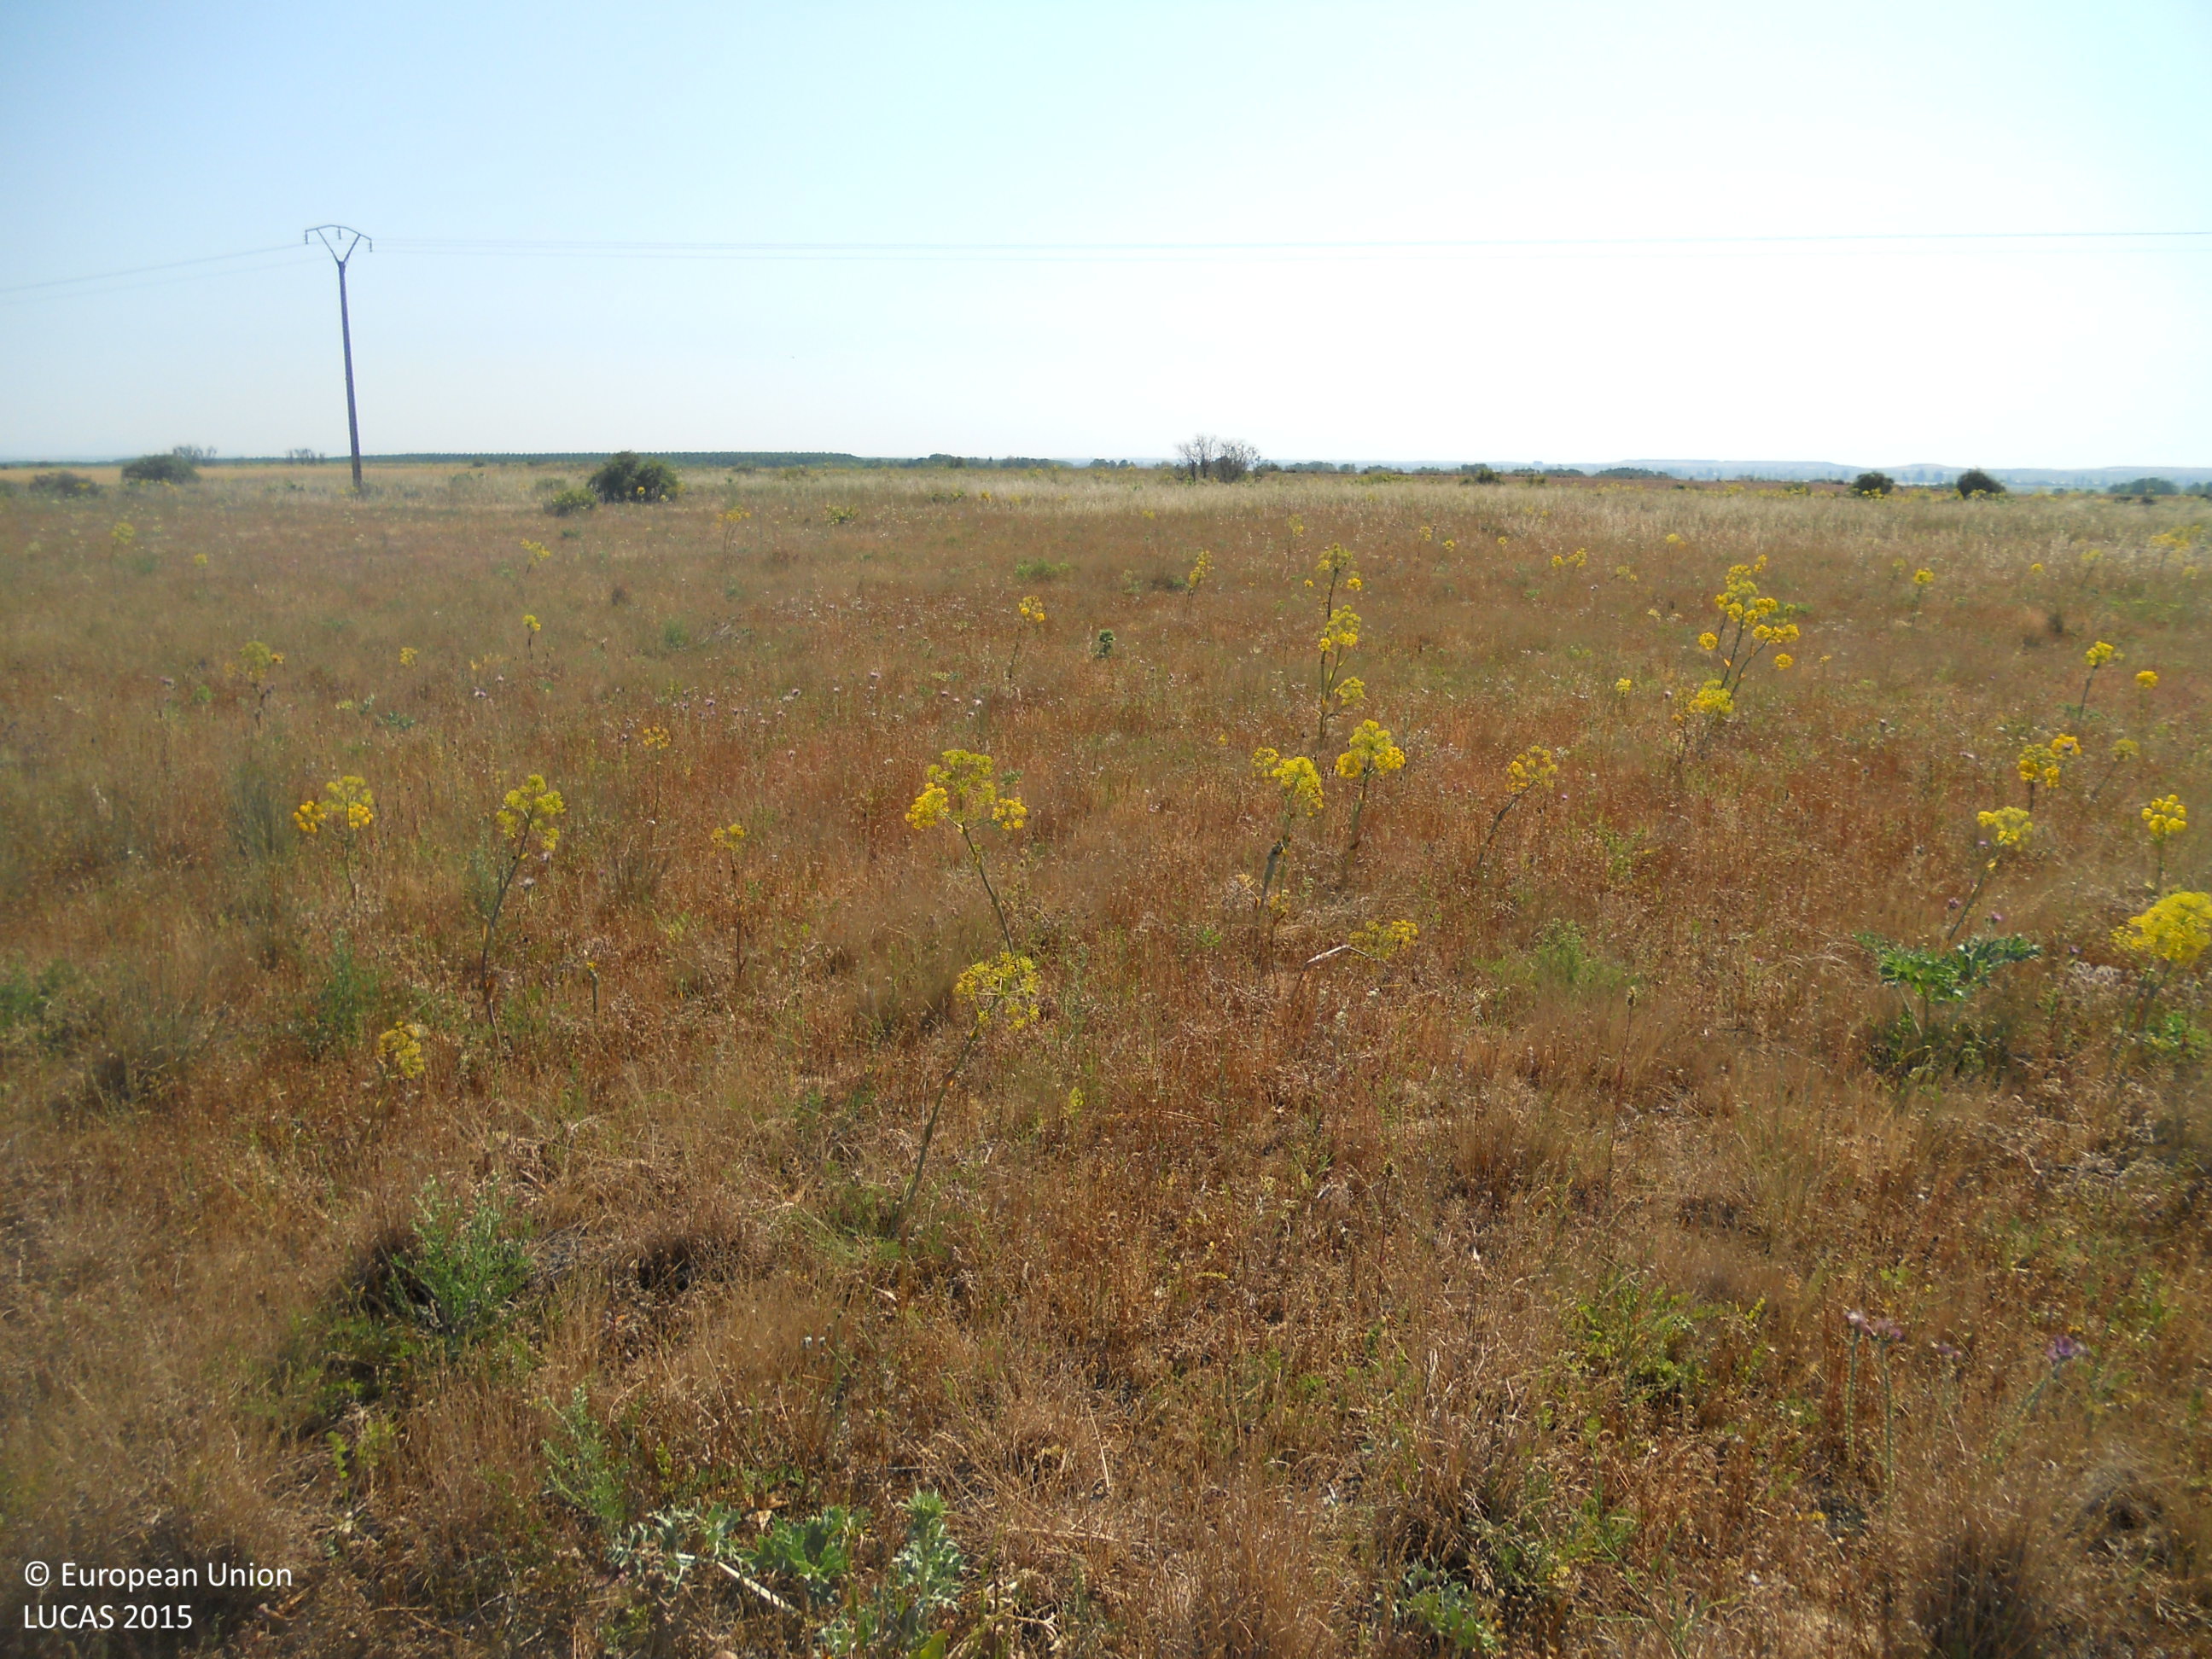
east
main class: Grassland
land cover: Grassland without tree/shrub cover
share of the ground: > 75 %
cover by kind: herbaceous plants 95 %, shrubs 5 %
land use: Semi-natural and natural areas not in use
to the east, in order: Grassland without tree/shrub cover; Electric lines; Grassland with sparse tree/shrub cover; Tracks; Grassland without tree/shrub cover; Tracks; Grass margins; Other bare soil
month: June
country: ES
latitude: 42.4152
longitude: -5.5644
